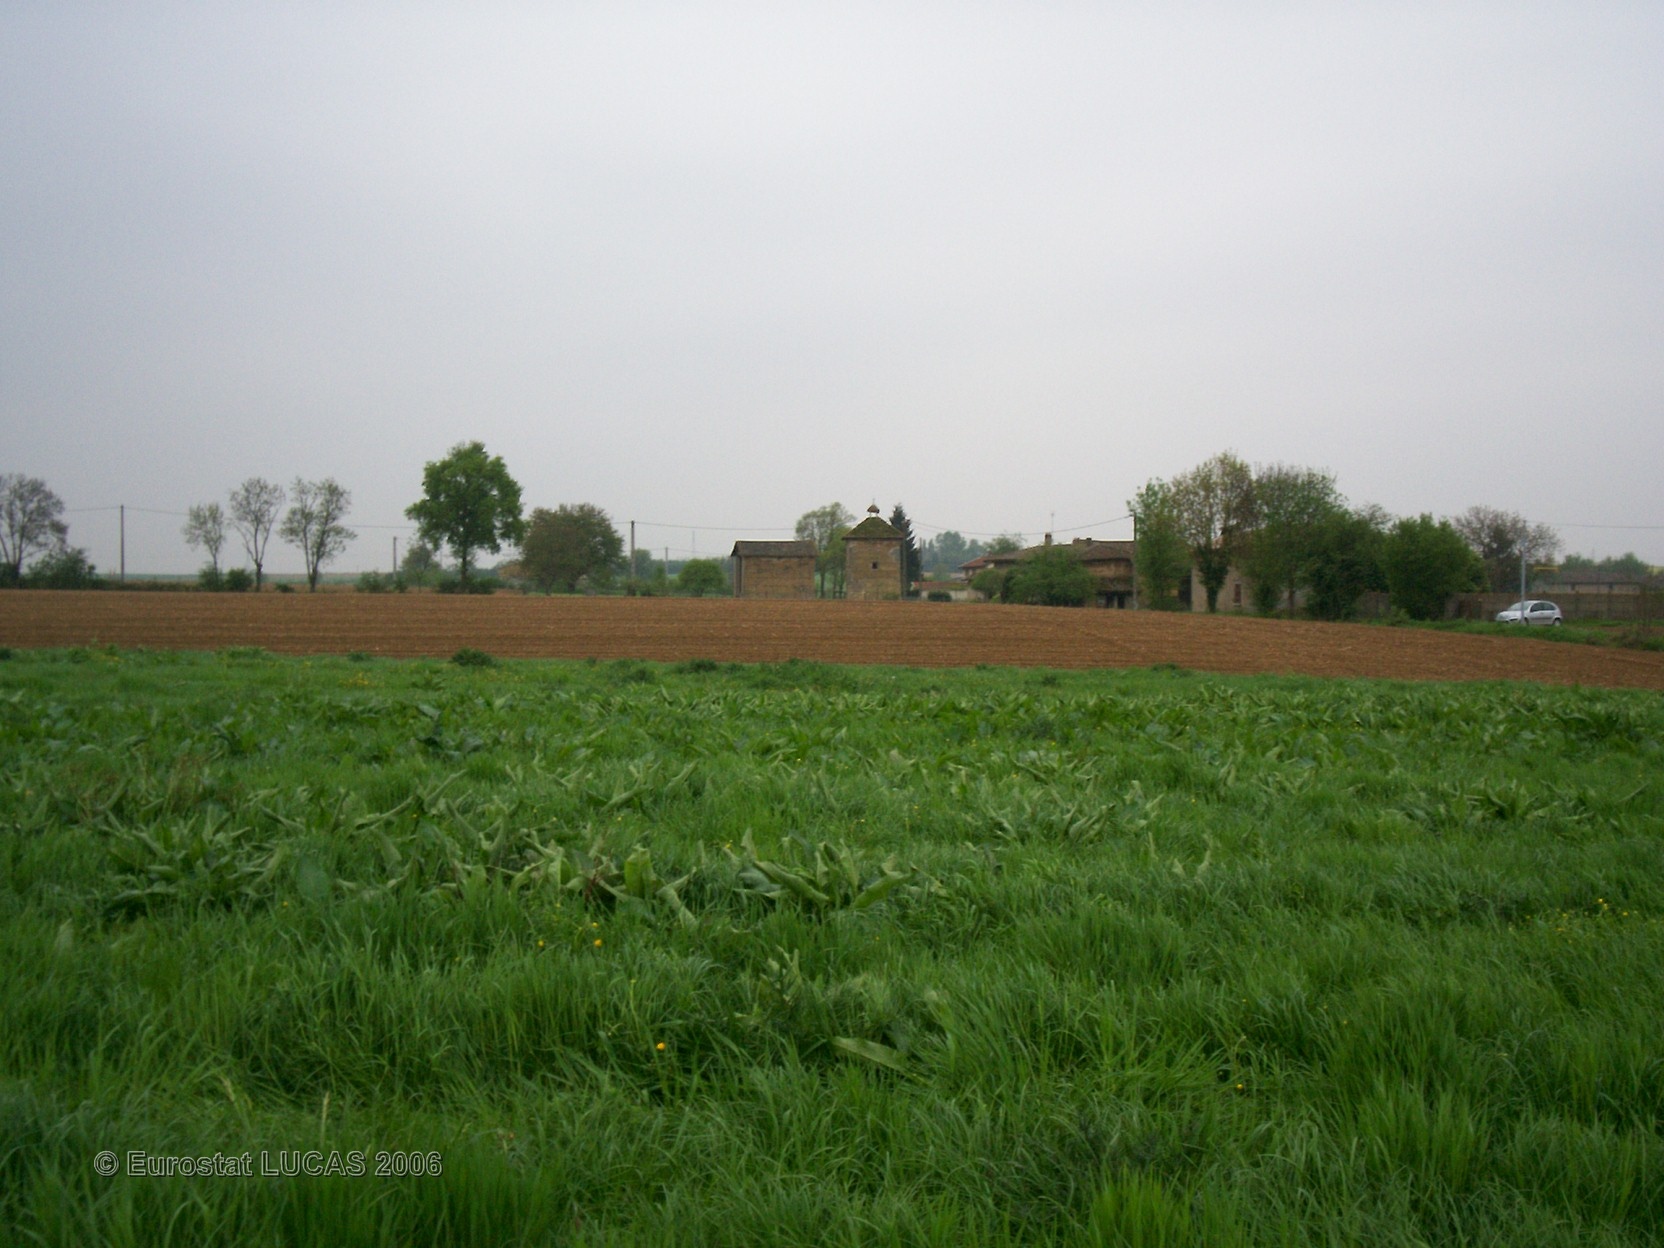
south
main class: Grassland
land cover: Grassland without tree/shrub cover
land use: Agriculture (excluding fallow land and kitchen gardens)
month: April
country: FR
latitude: 46.0261
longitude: 4.7967
